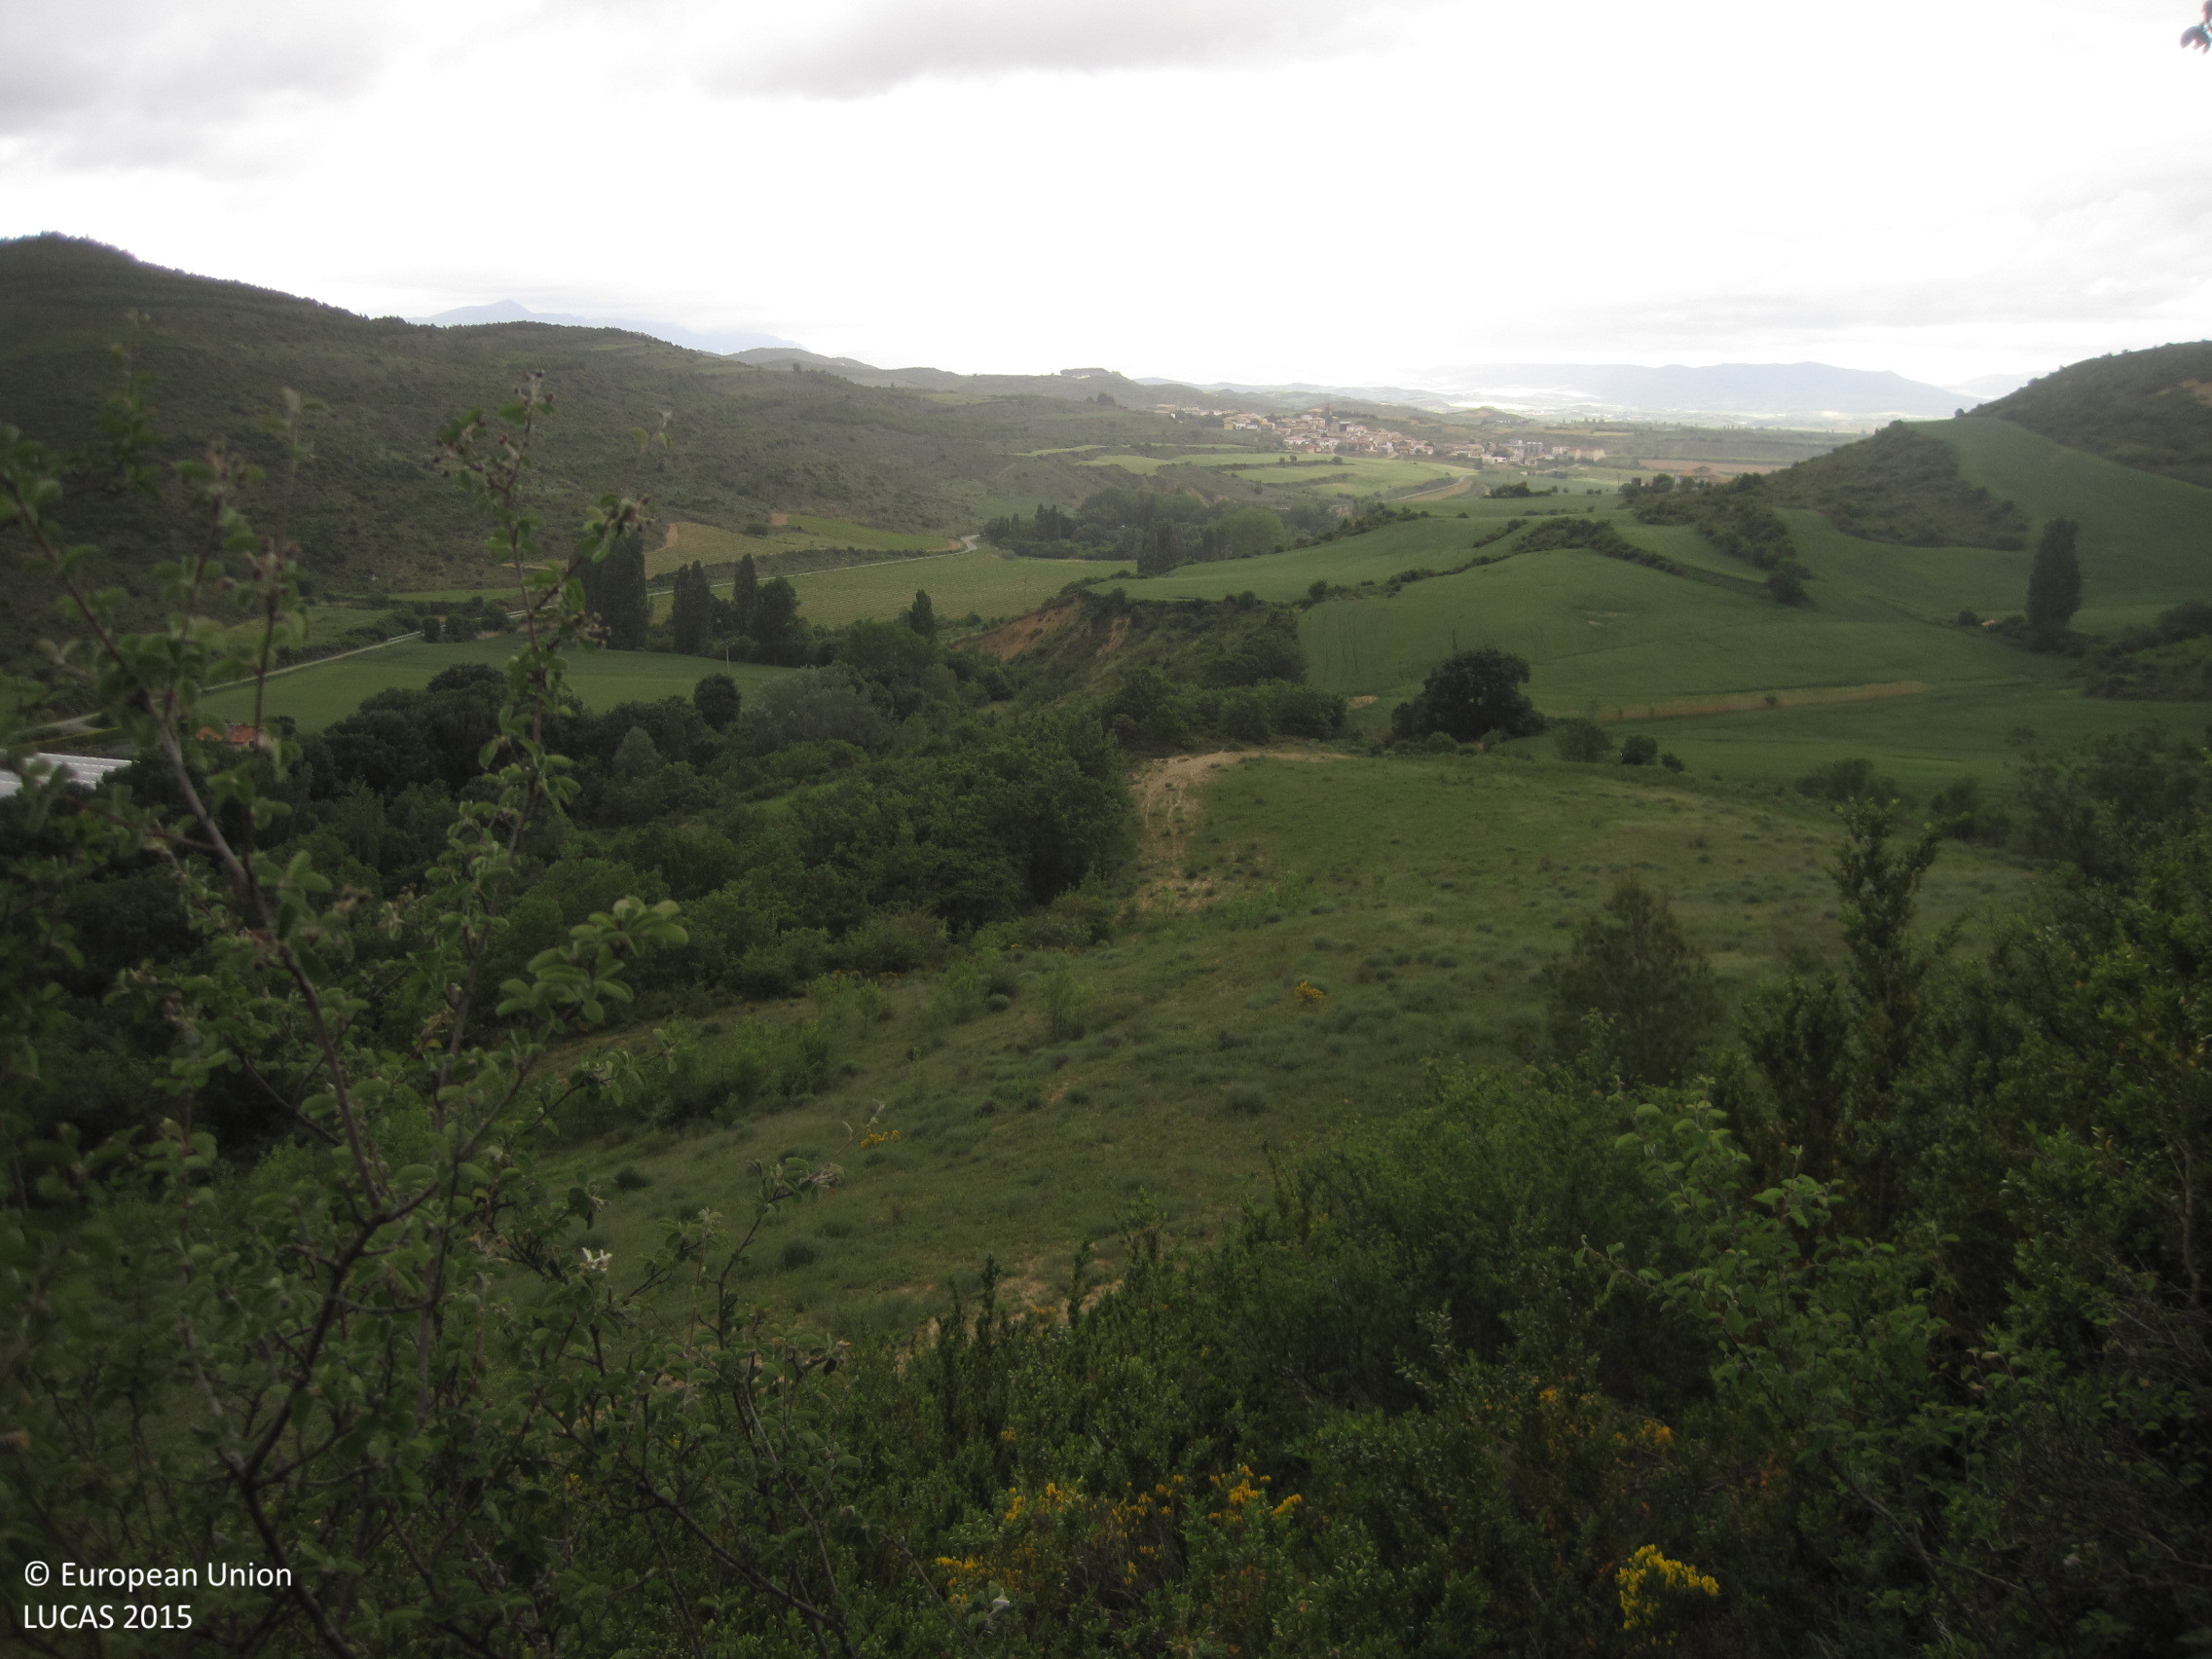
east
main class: Shrubland
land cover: Shrubland without tree cover
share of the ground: > 75 %
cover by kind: shrubs 95 %, herbaceous plants 5 %
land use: Semi-natural and natural areas not in use
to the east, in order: Shrubland without tree cover; Spontaneously vegetated surfaces; Broadleaved woodland
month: May
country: ES
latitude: 42.5880
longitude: -1.4285
